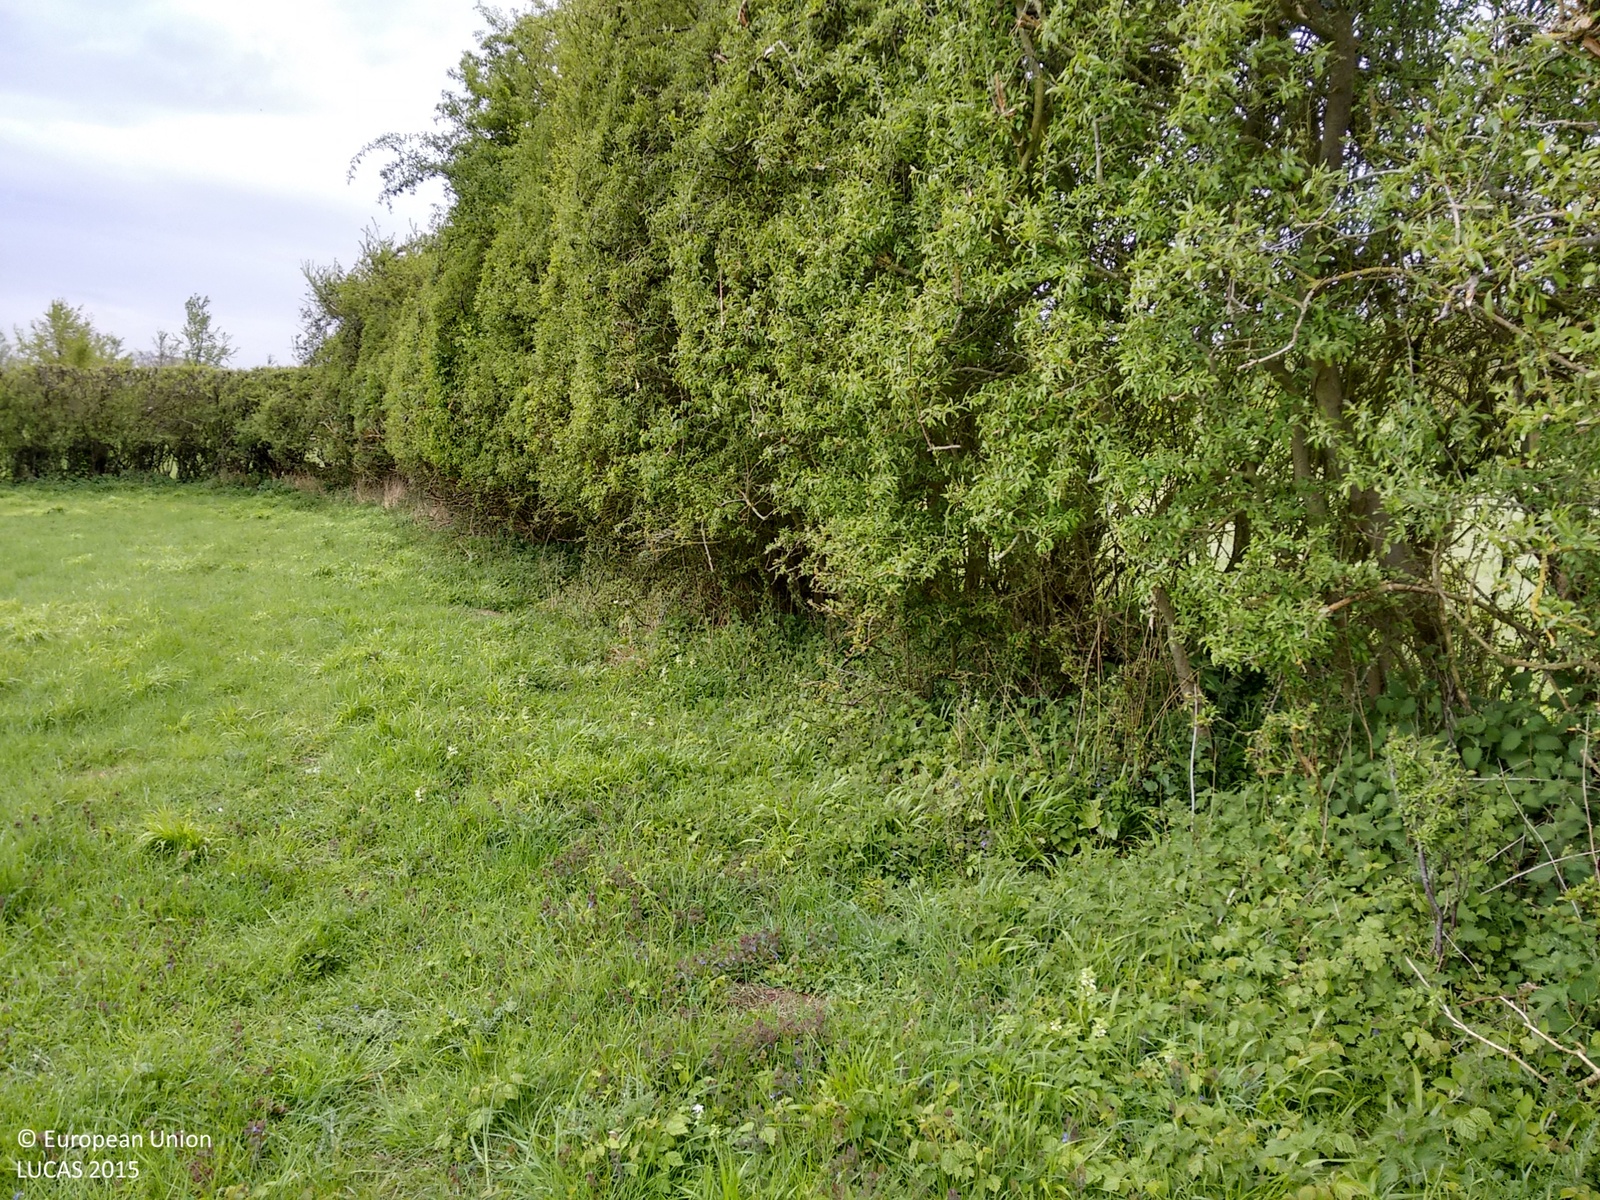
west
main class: Grassland
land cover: Grassland without tree/shrub cover
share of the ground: > 75 %
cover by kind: herbaceous plants 100 %
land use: Sport
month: May
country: GB
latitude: 51.8096
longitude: -0.6133
